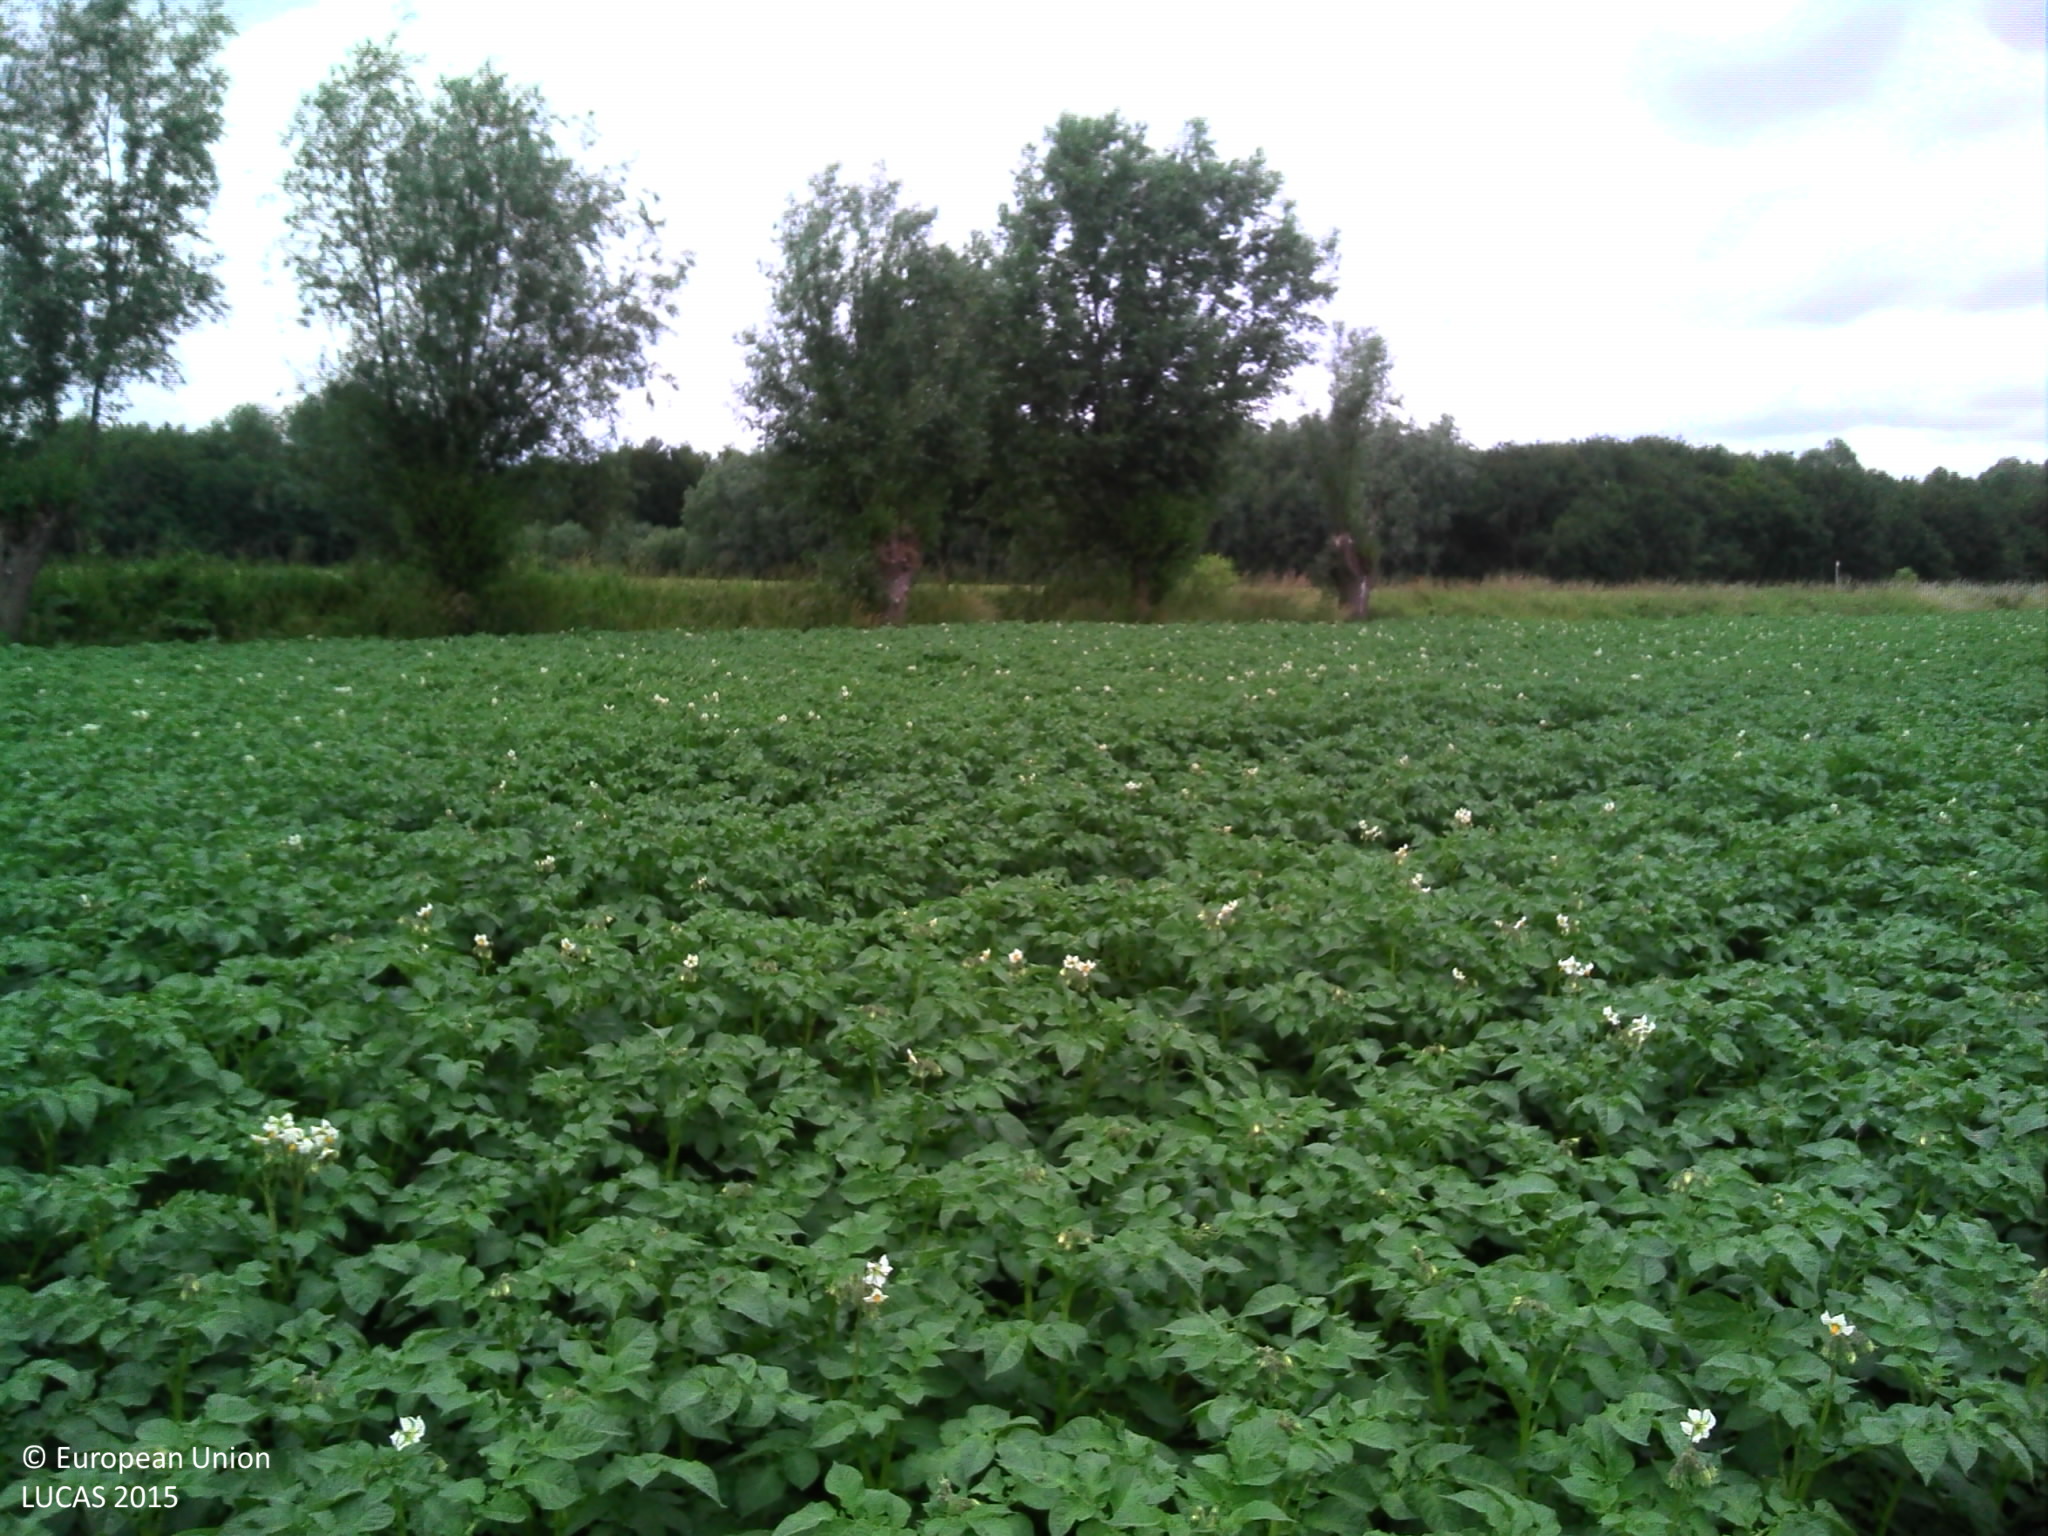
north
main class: Cropland
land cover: Potatoes
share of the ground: > 75 %
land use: Agriculture (excluding fallow land and kitchen gardens)
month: June
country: BE
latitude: 51.1623
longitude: 4.0025
